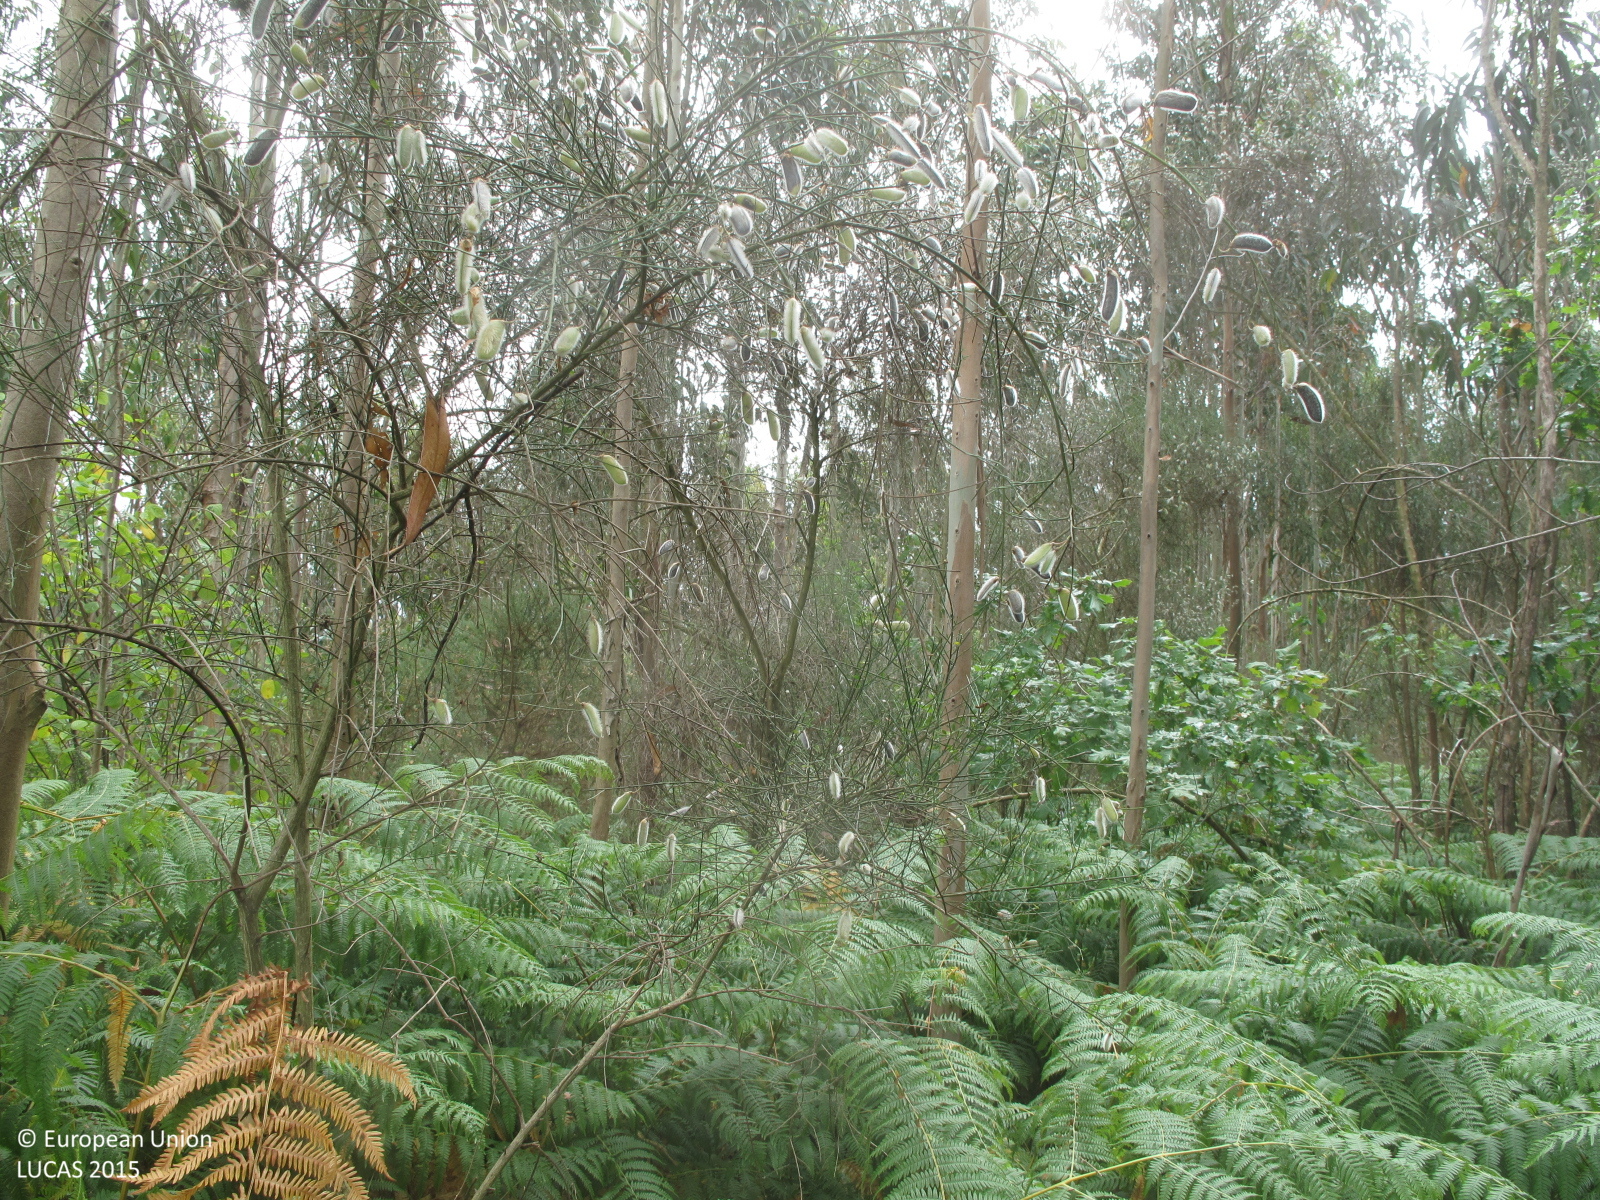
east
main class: Woodland
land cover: Broadleaved woodland
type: exotic forest
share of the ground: 50 - 75 %
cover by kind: broadleaved forest trees 60 %, shrubs 20 %, herbaceous plants 20 %
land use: Forestry
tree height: > 5 m
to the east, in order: Broadleaved woodland; Paved roads, cycling and walking lanes; Shrubland without tree cover; Broadleaved woodland; Shrubland without tree cover; Broadleaved woodland; Tracks; Broadleaved woodland
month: July
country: ES
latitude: 43.5306
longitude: -8.1289
